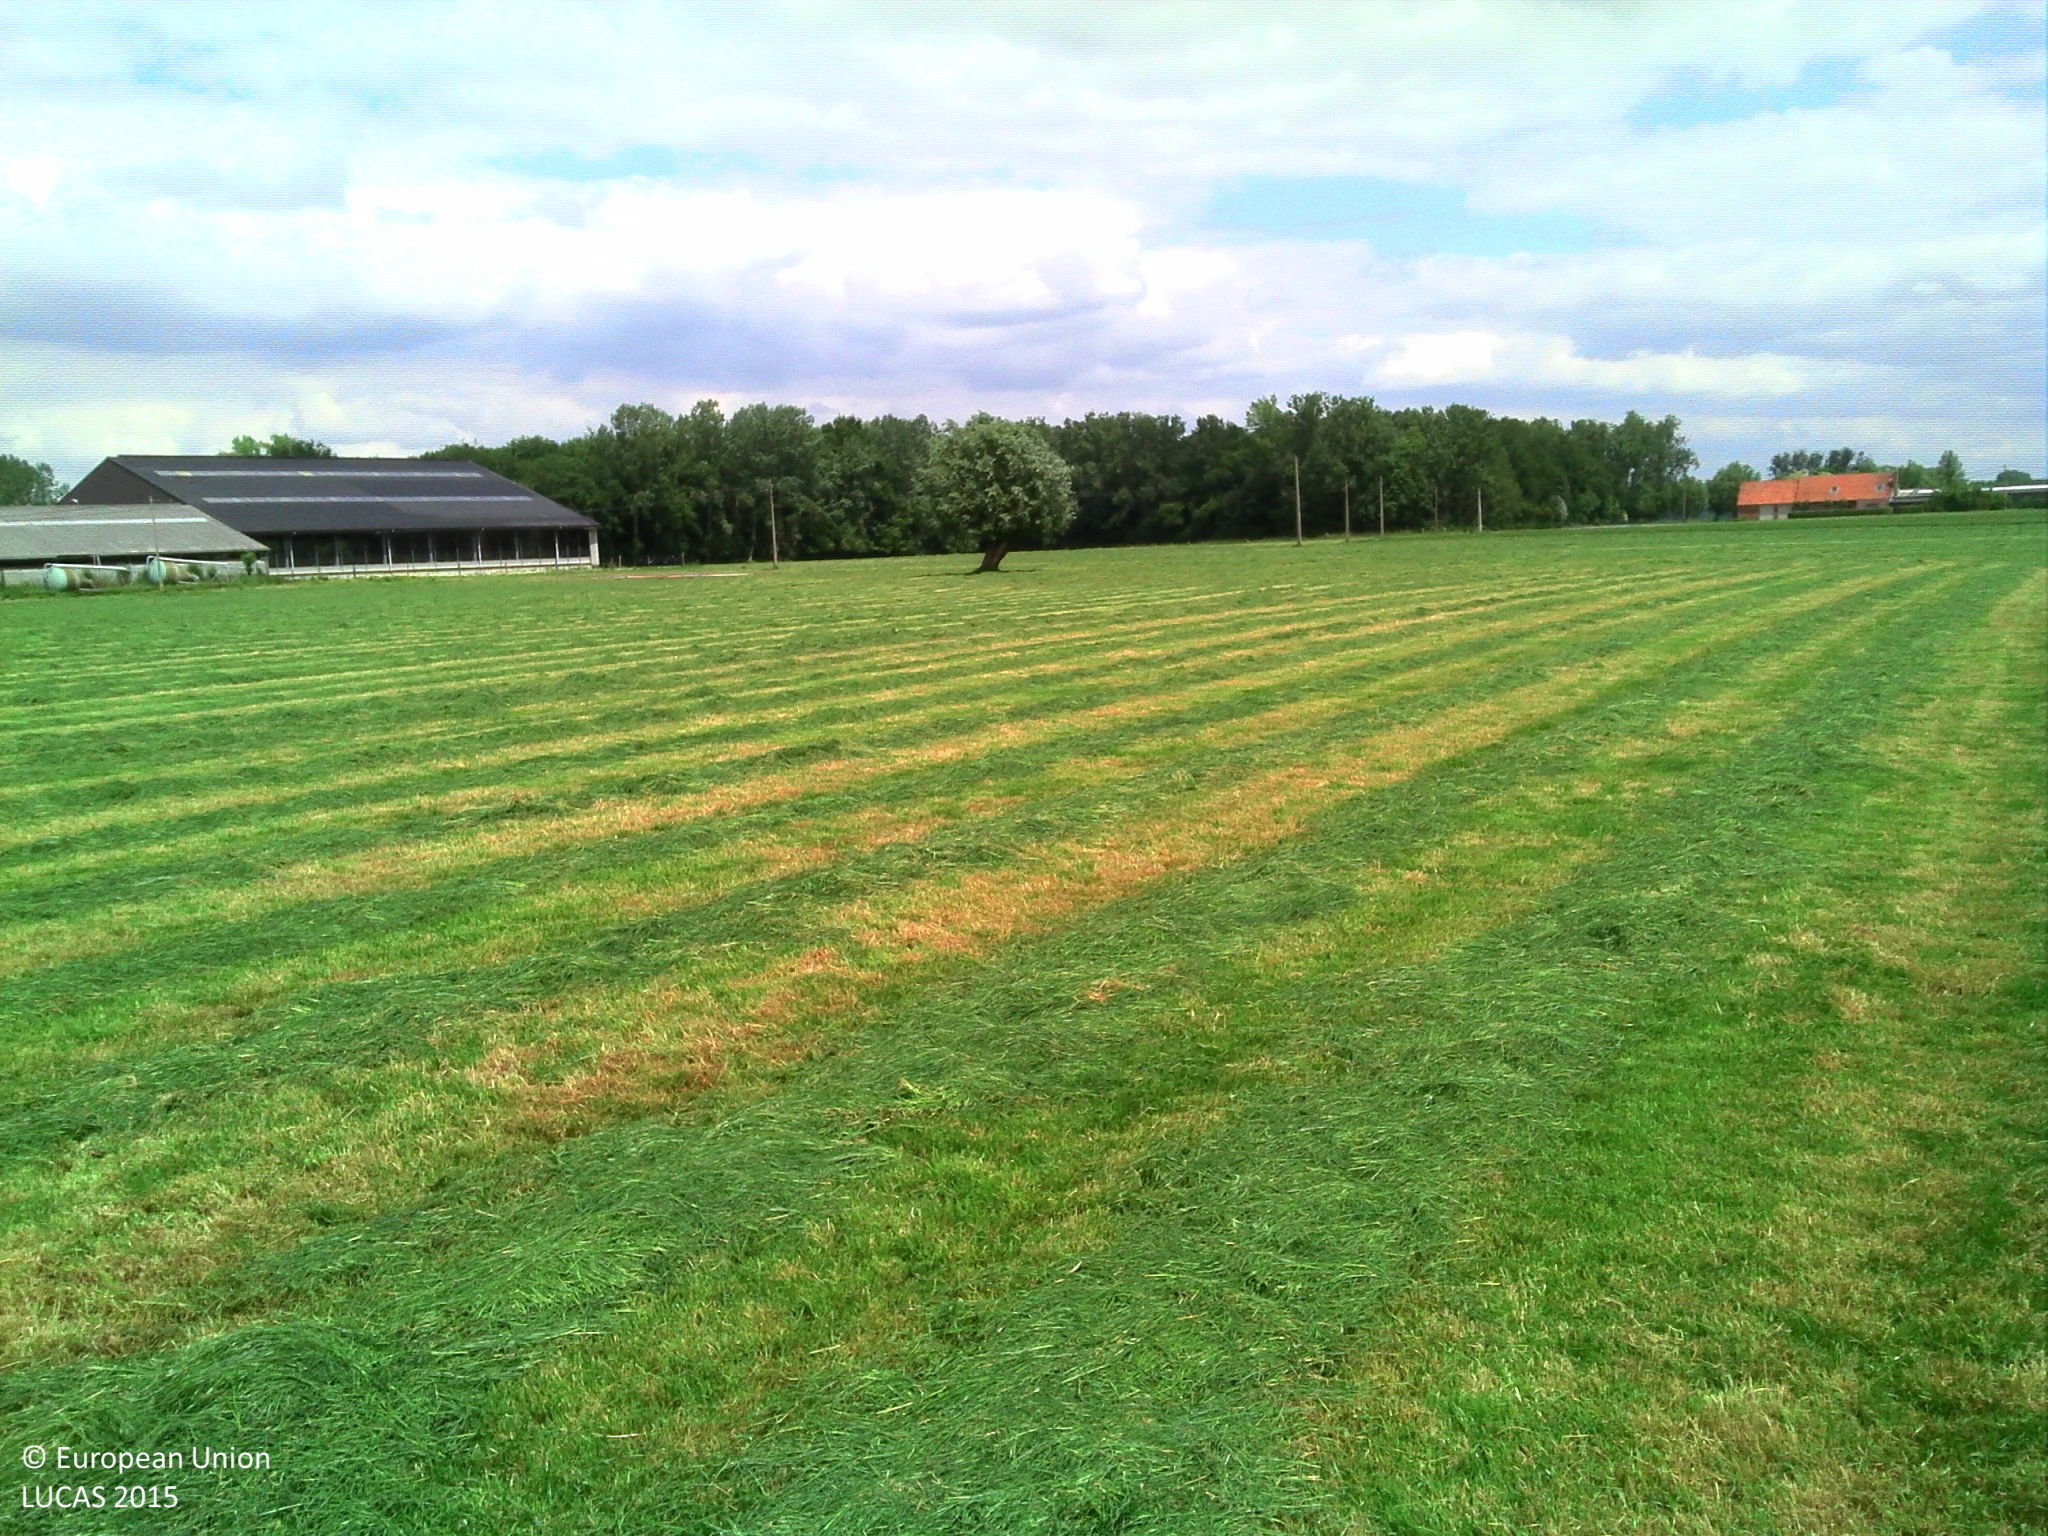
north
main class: Cropland
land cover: Temporary grasslands
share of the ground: > 75 %
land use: Agriculture (excluding fallow land and kitchen gardens)
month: June
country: BE
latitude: 50.8583
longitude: 2.7862
